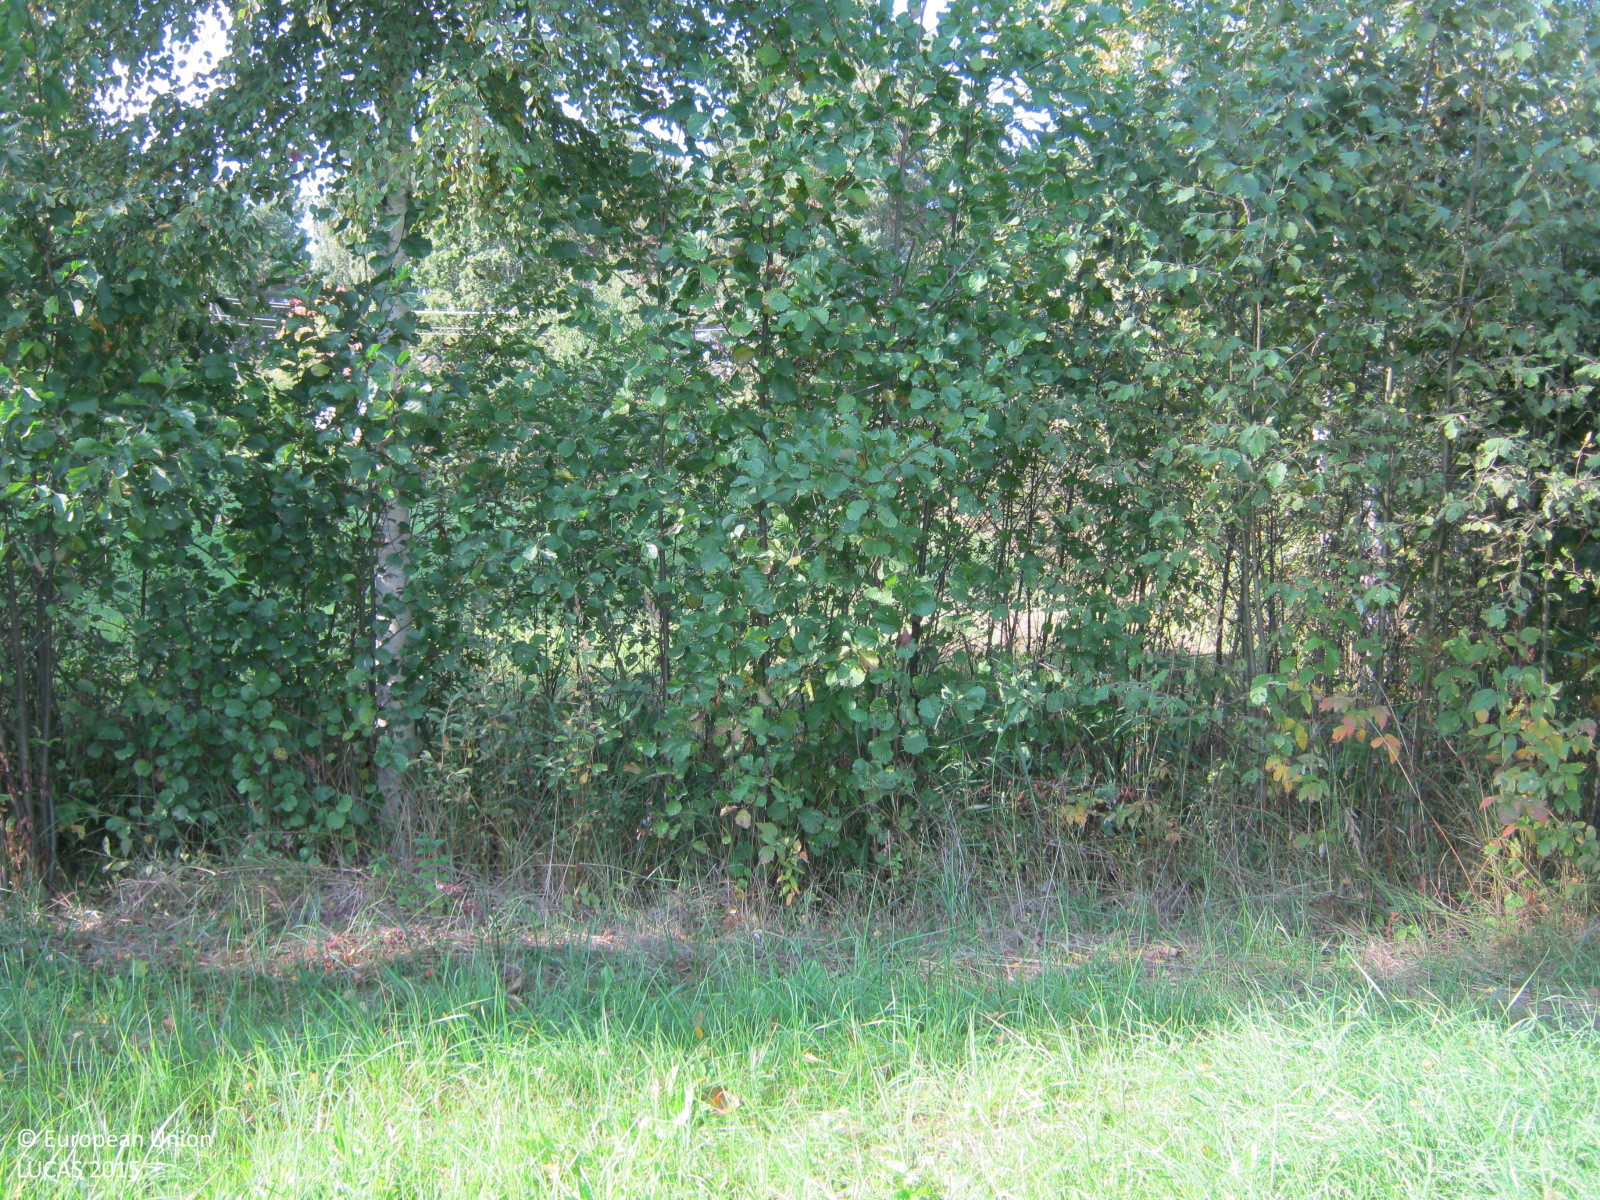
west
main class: Grassland
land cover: Grassland without tree/shrub cover
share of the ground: > 75 %
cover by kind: herbaceous plants 100 %
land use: Agriculture (excluding fallow land and kitchen gardens)
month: September
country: LV
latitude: 57.3644
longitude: 24.4043
